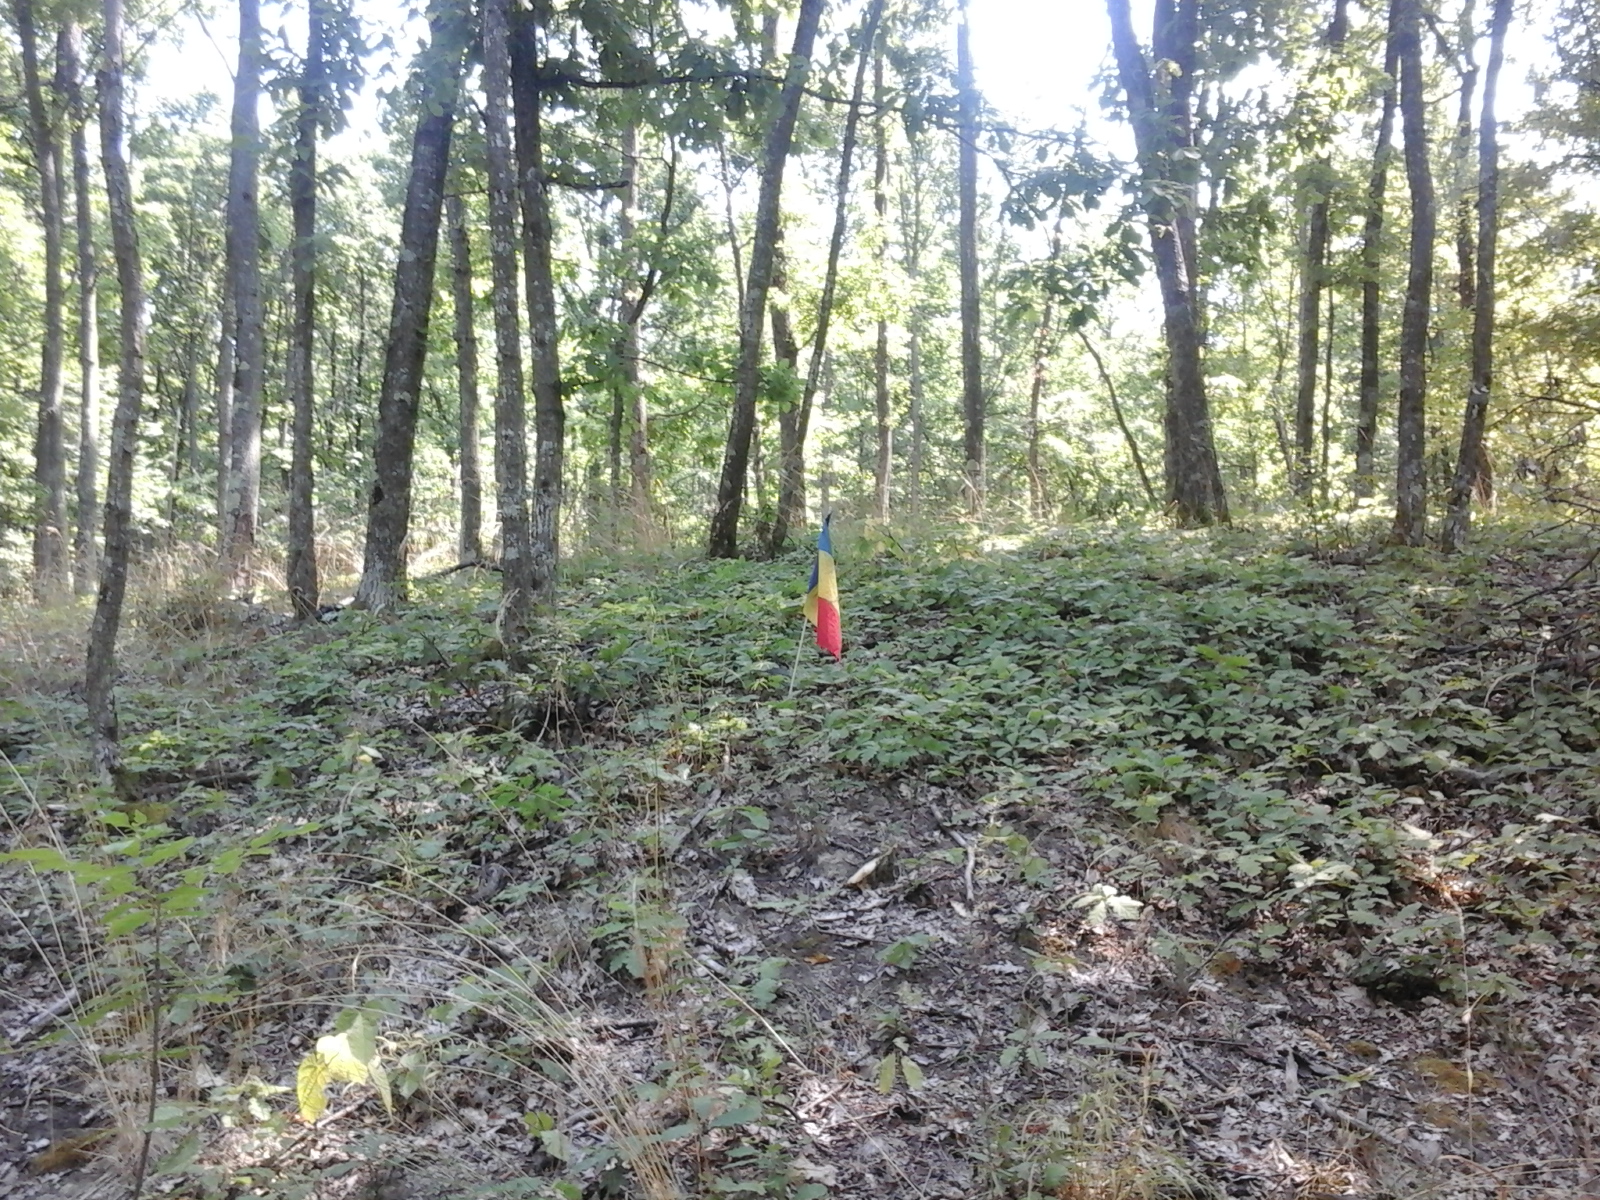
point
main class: Woodland
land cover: Broadleaved woodland
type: acidophilous oak and oak-birch forest
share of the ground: > 75 %
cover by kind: broadleaved forest trees 100 %
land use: Forestry
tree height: > 5 m
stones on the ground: < 10 %
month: August
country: RO
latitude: 44.8048
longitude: 23.8554
